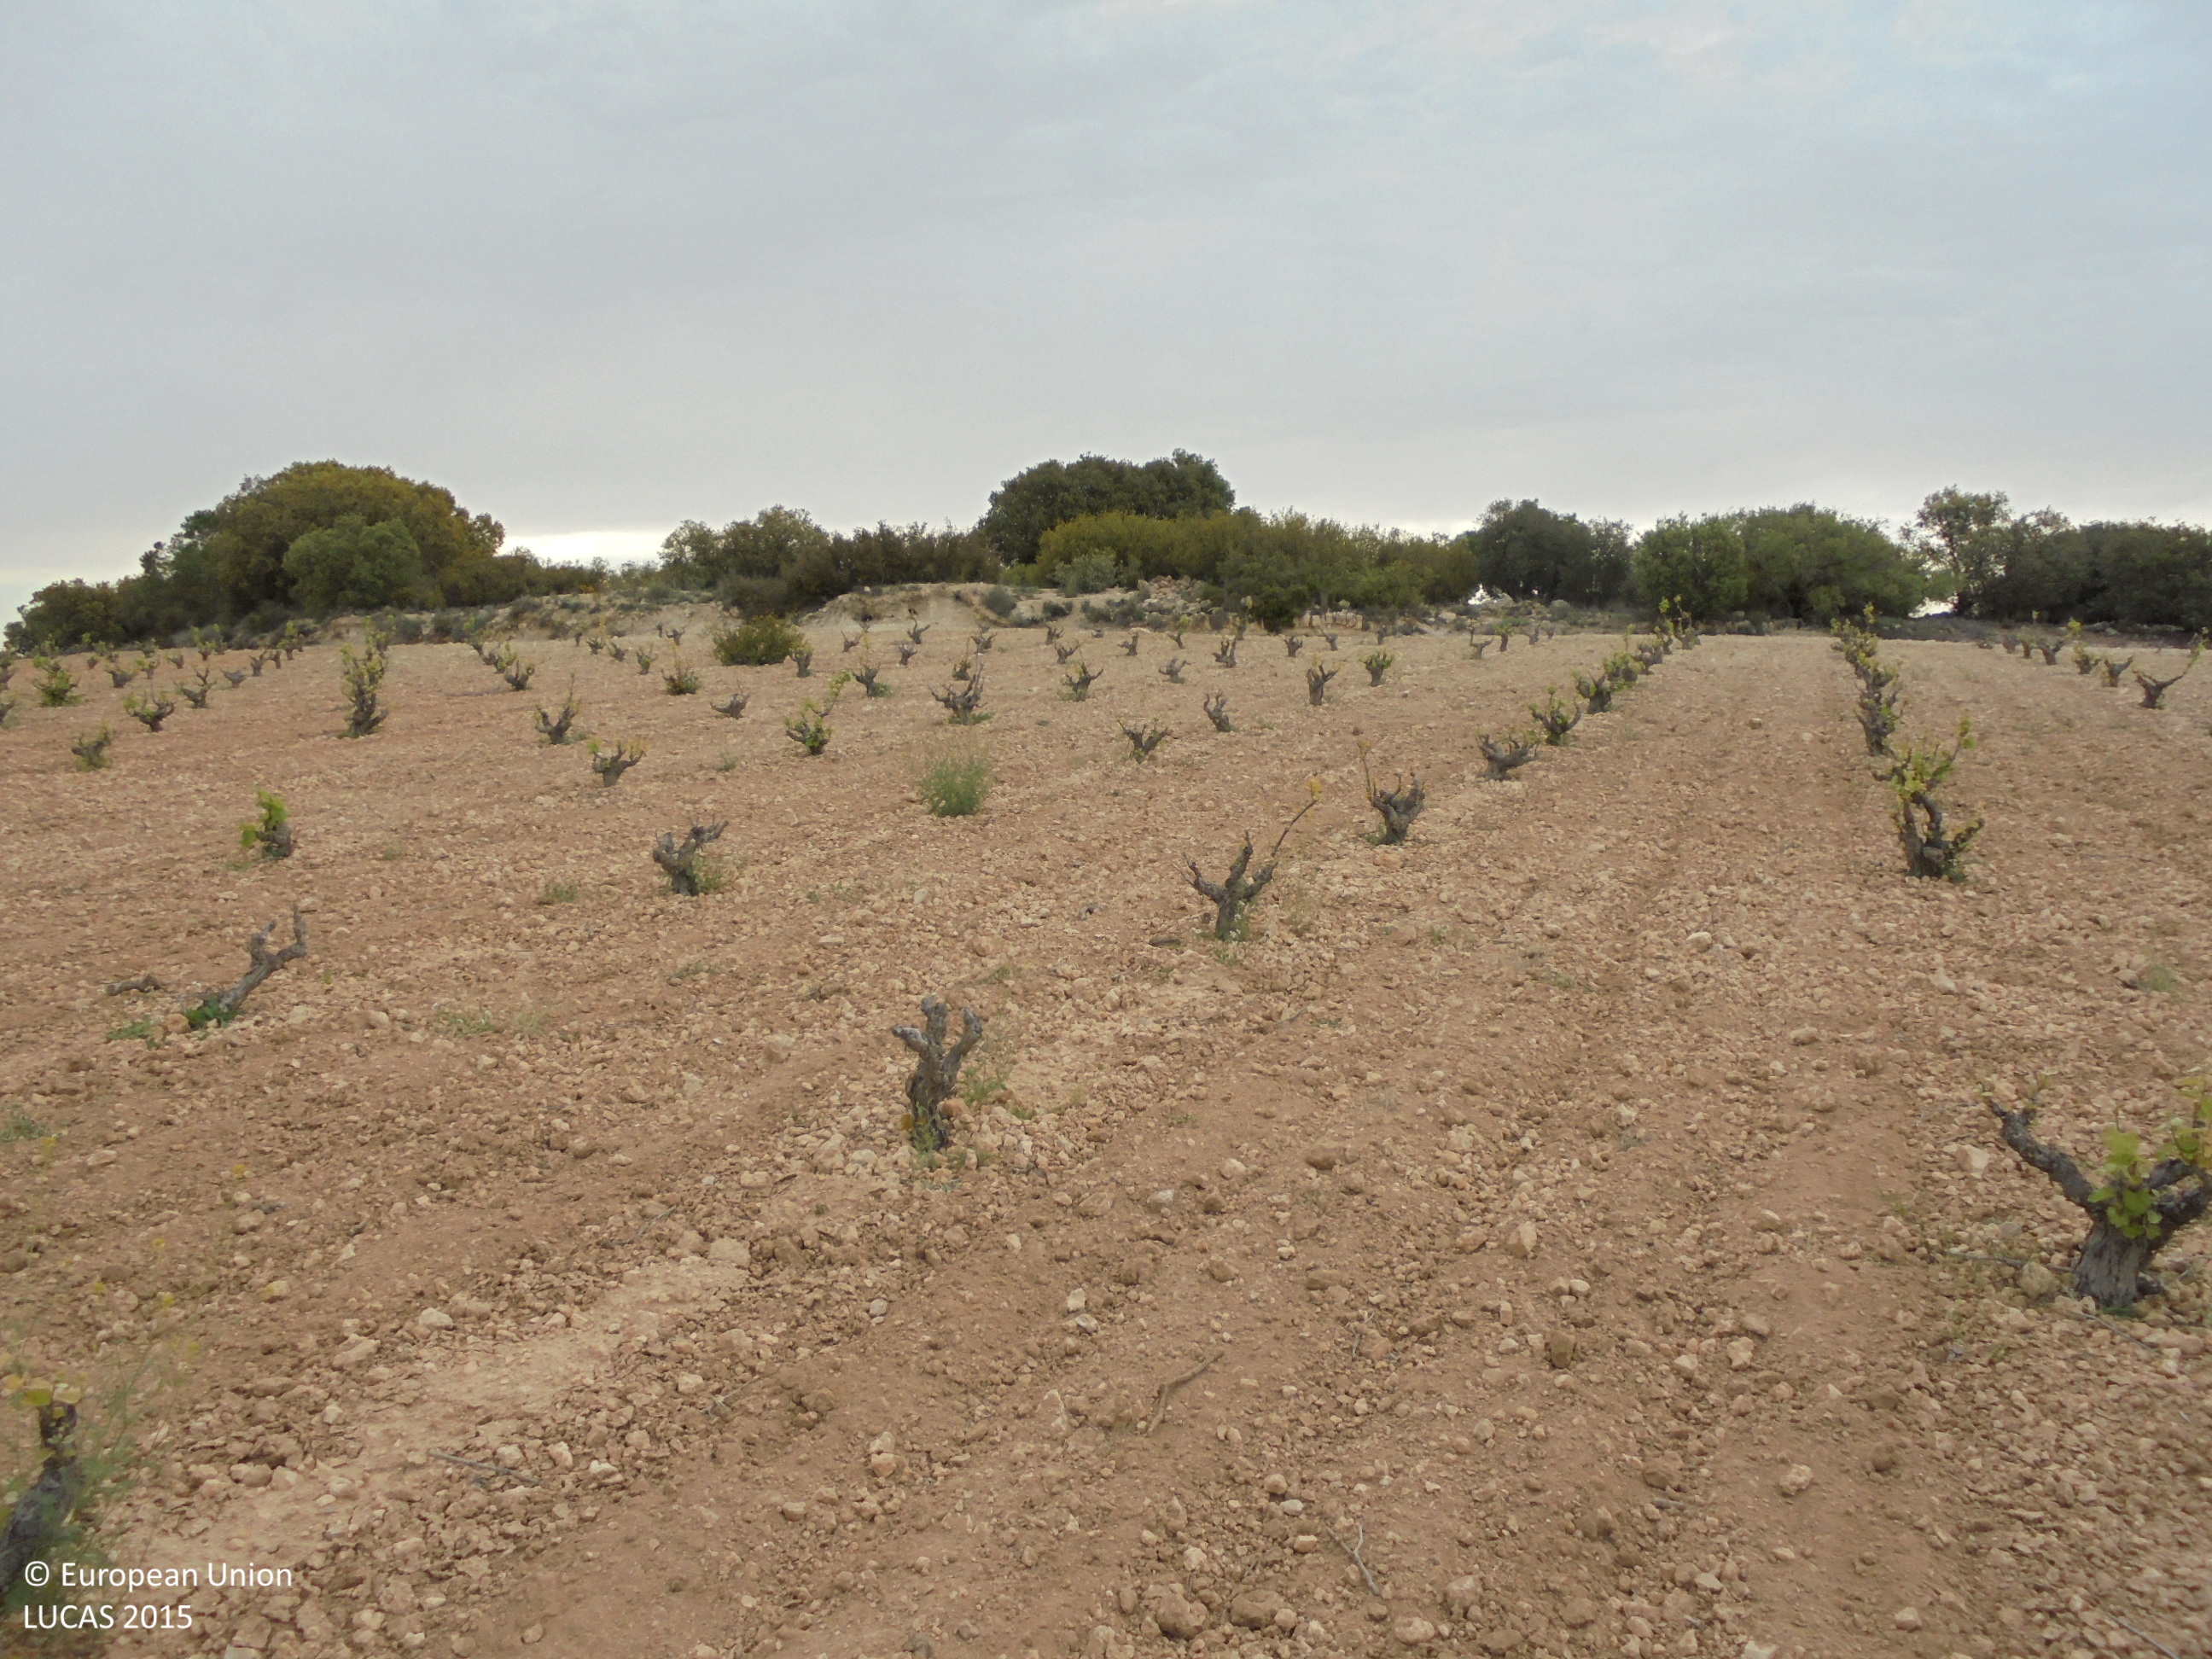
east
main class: Cropland
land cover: Vineyards
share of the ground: < 10 %
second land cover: Other bare soil
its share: > 75 %
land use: Agriculture (excluding fallow land and kitchen gardens)
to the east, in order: Vineyards; Other bare soil; Broadleaved woodland; Spontaneously vegetated surfaces; Broadleaved woodland; Spontaneously vegetated surfaces
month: May
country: ES
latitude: 39.1928
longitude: -1.7540
